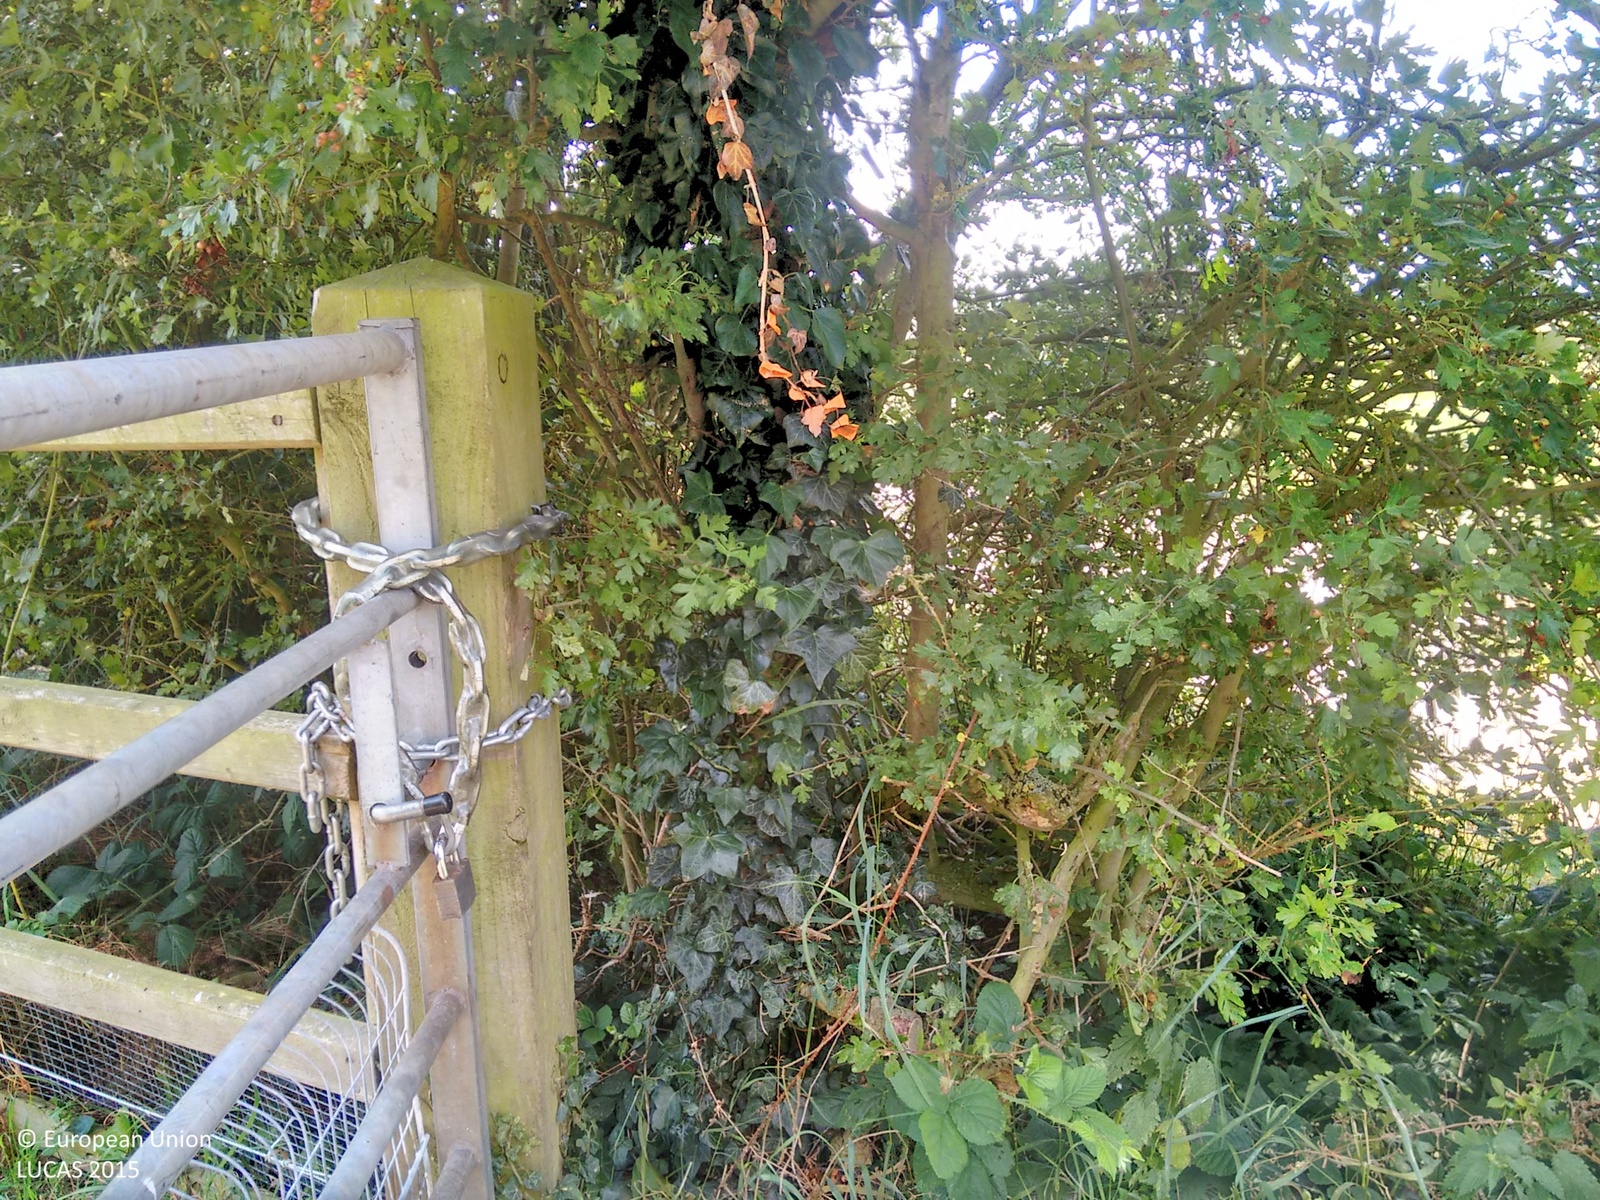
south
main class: Grassland
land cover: Grassland without tree/shrub cover
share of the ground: > 75 %
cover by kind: herbaceous plants 100 %
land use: Agriculture (excluding fallow land and kitchen gardens)
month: August
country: GB
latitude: 52.6160
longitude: -1.4974
